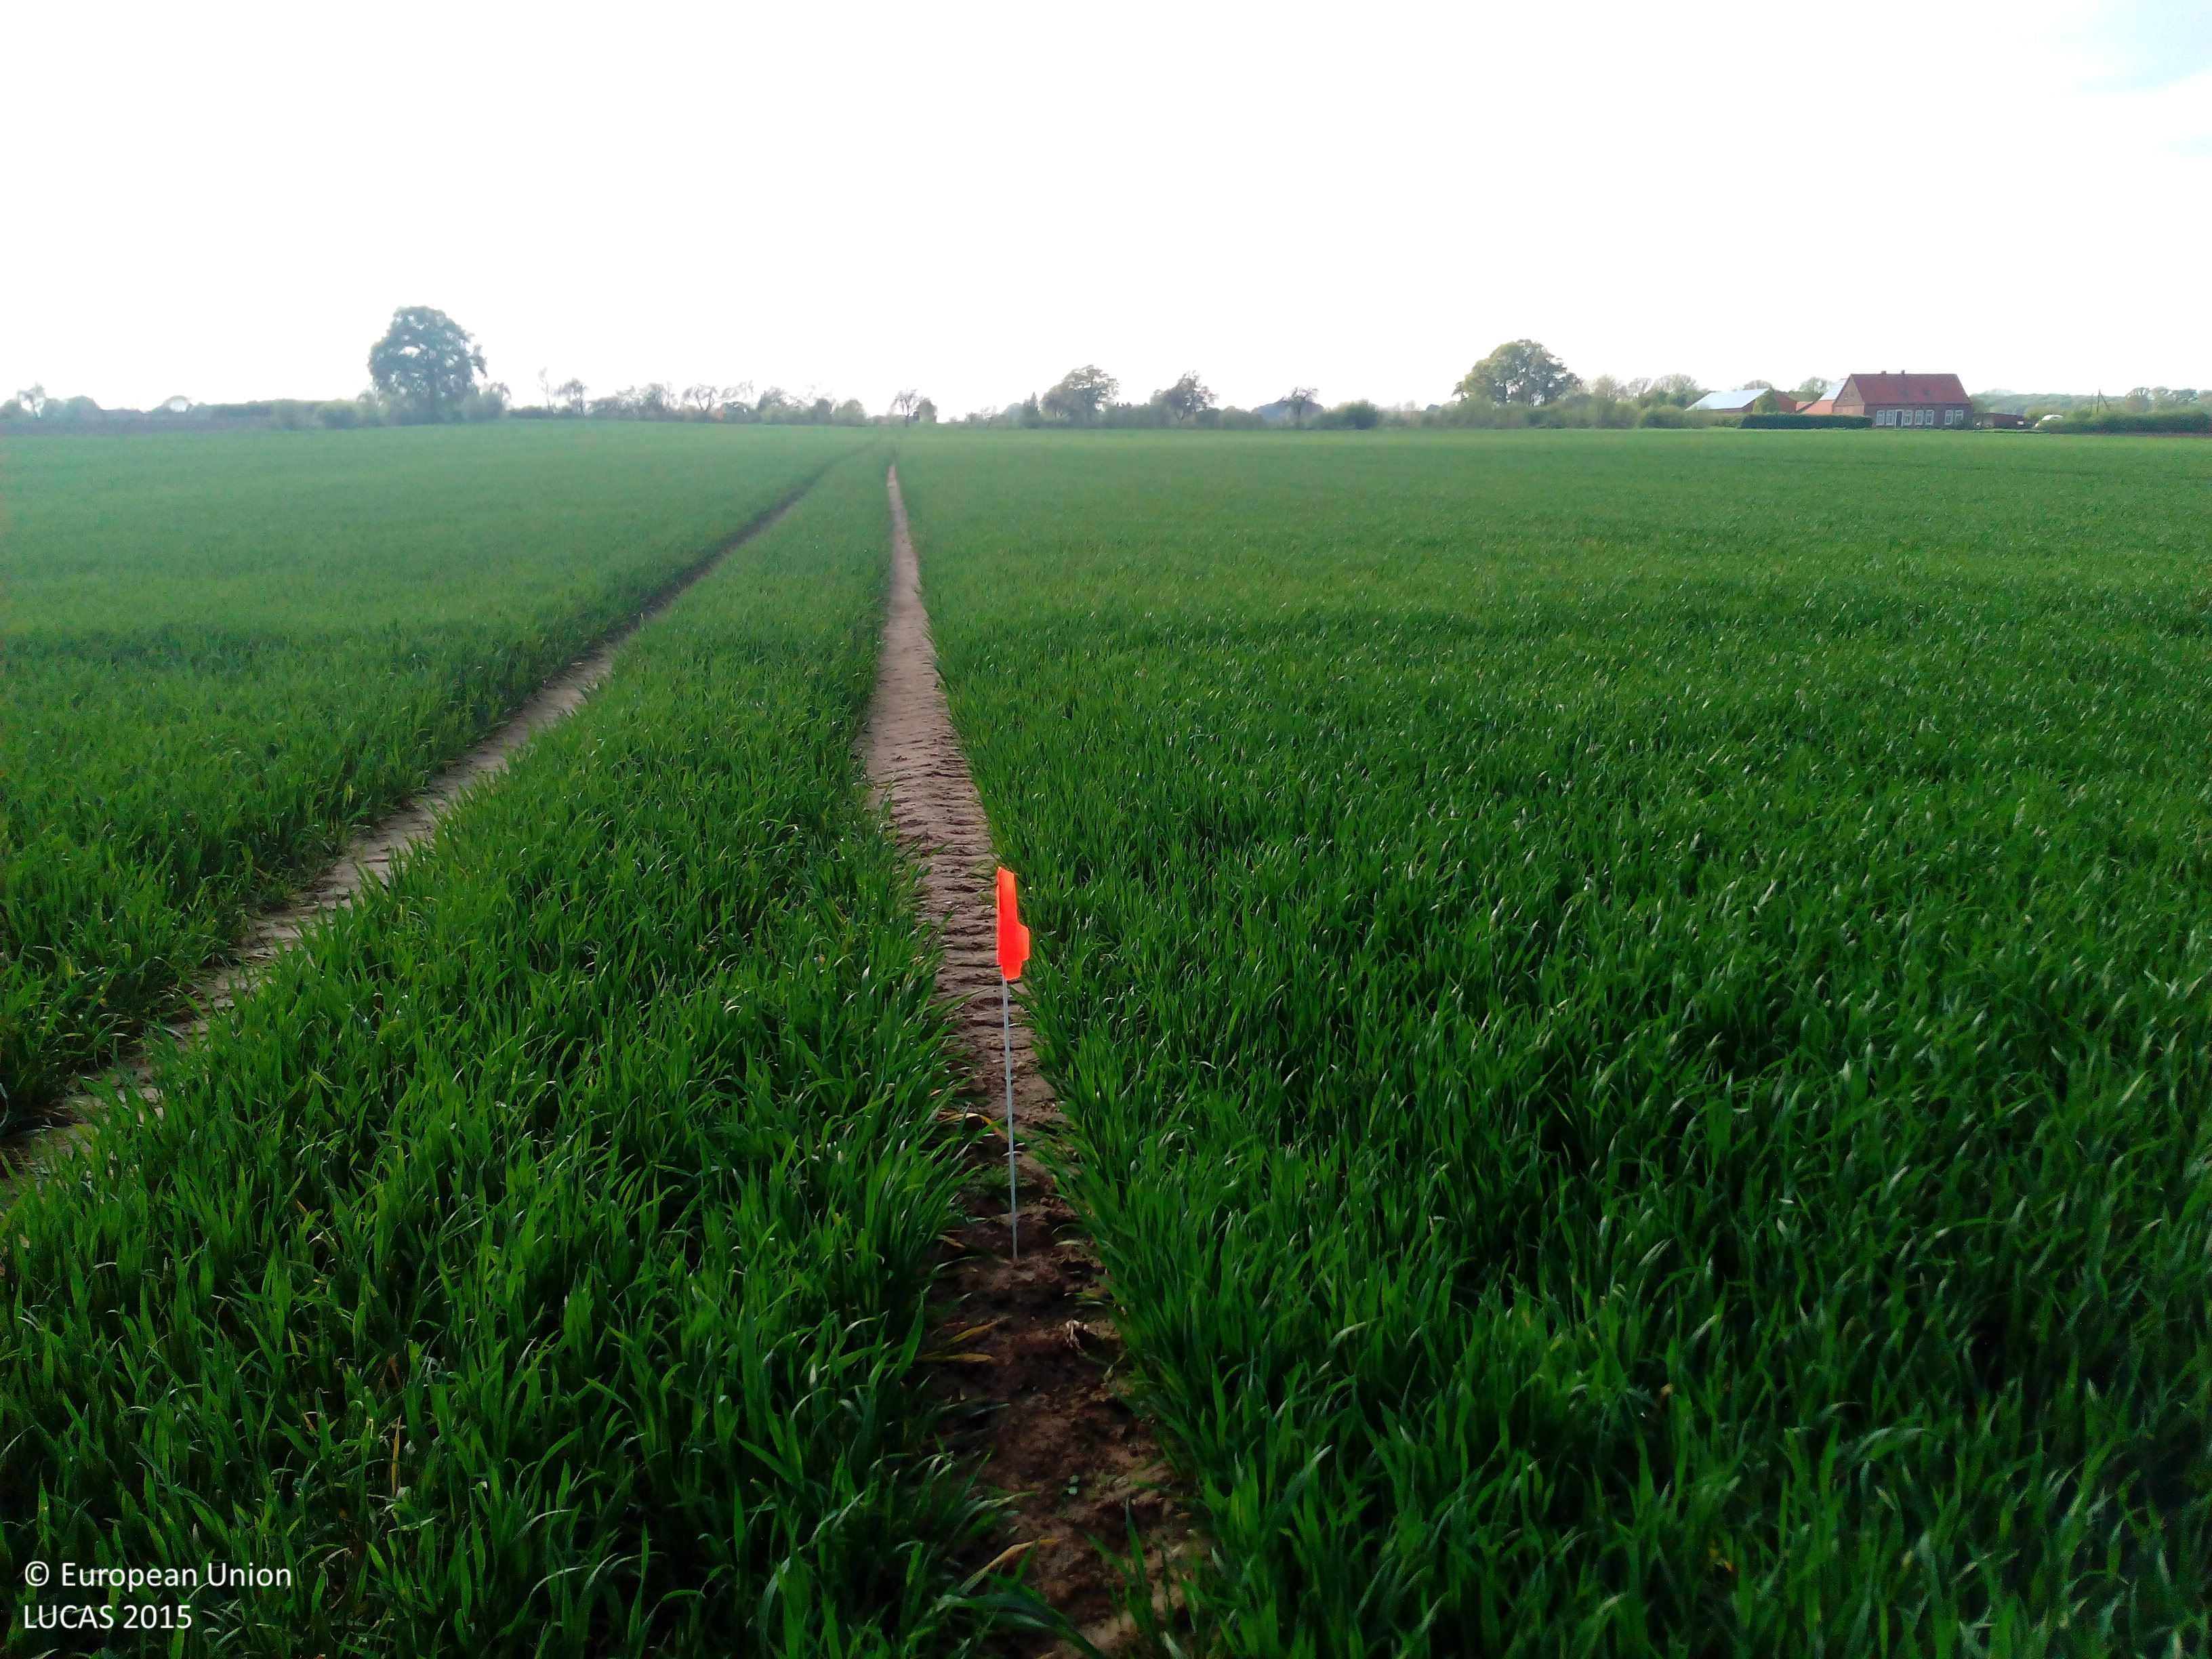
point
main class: Cropland
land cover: Triticale
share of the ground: > 75 %
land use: Agriculture (excluding fallow land and kitchen gardens)
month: May
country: DE
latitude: 52.0251
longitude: 7.3915
